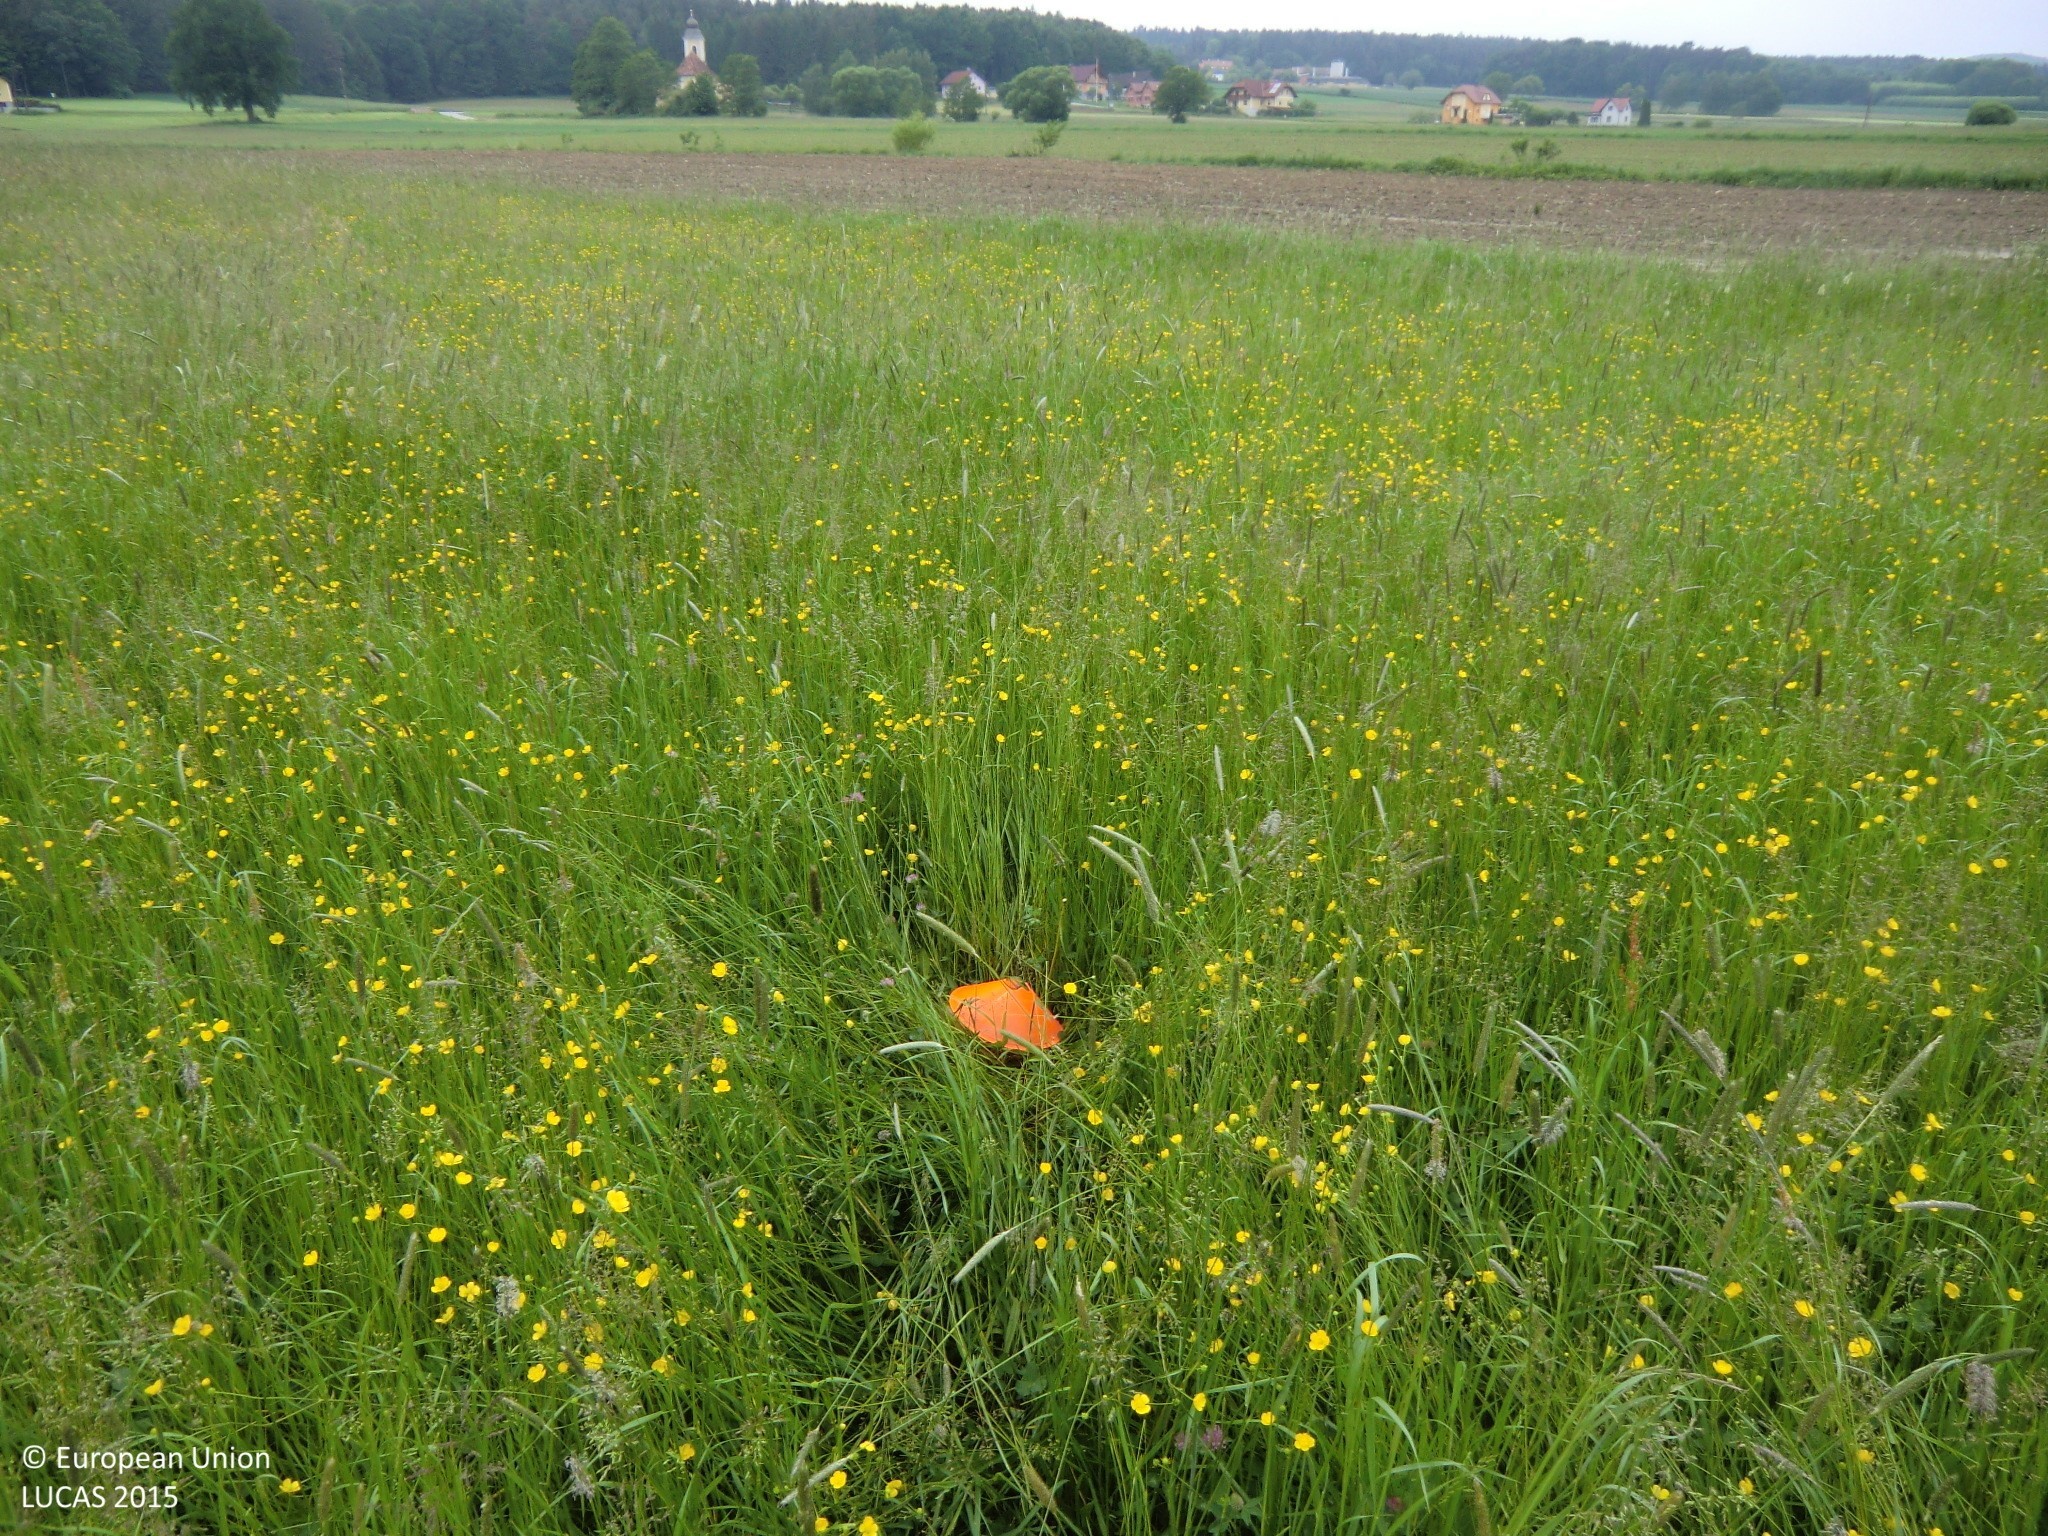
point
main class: Grassland
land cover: Grassland without tree/shrub cover
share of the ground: > 75 %
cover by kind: herbaceous plants 100 %
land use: Agriculture (excluding fallow land and kitchen gardens)
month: May
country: AT
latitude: 47.3549
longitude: 16.0256
